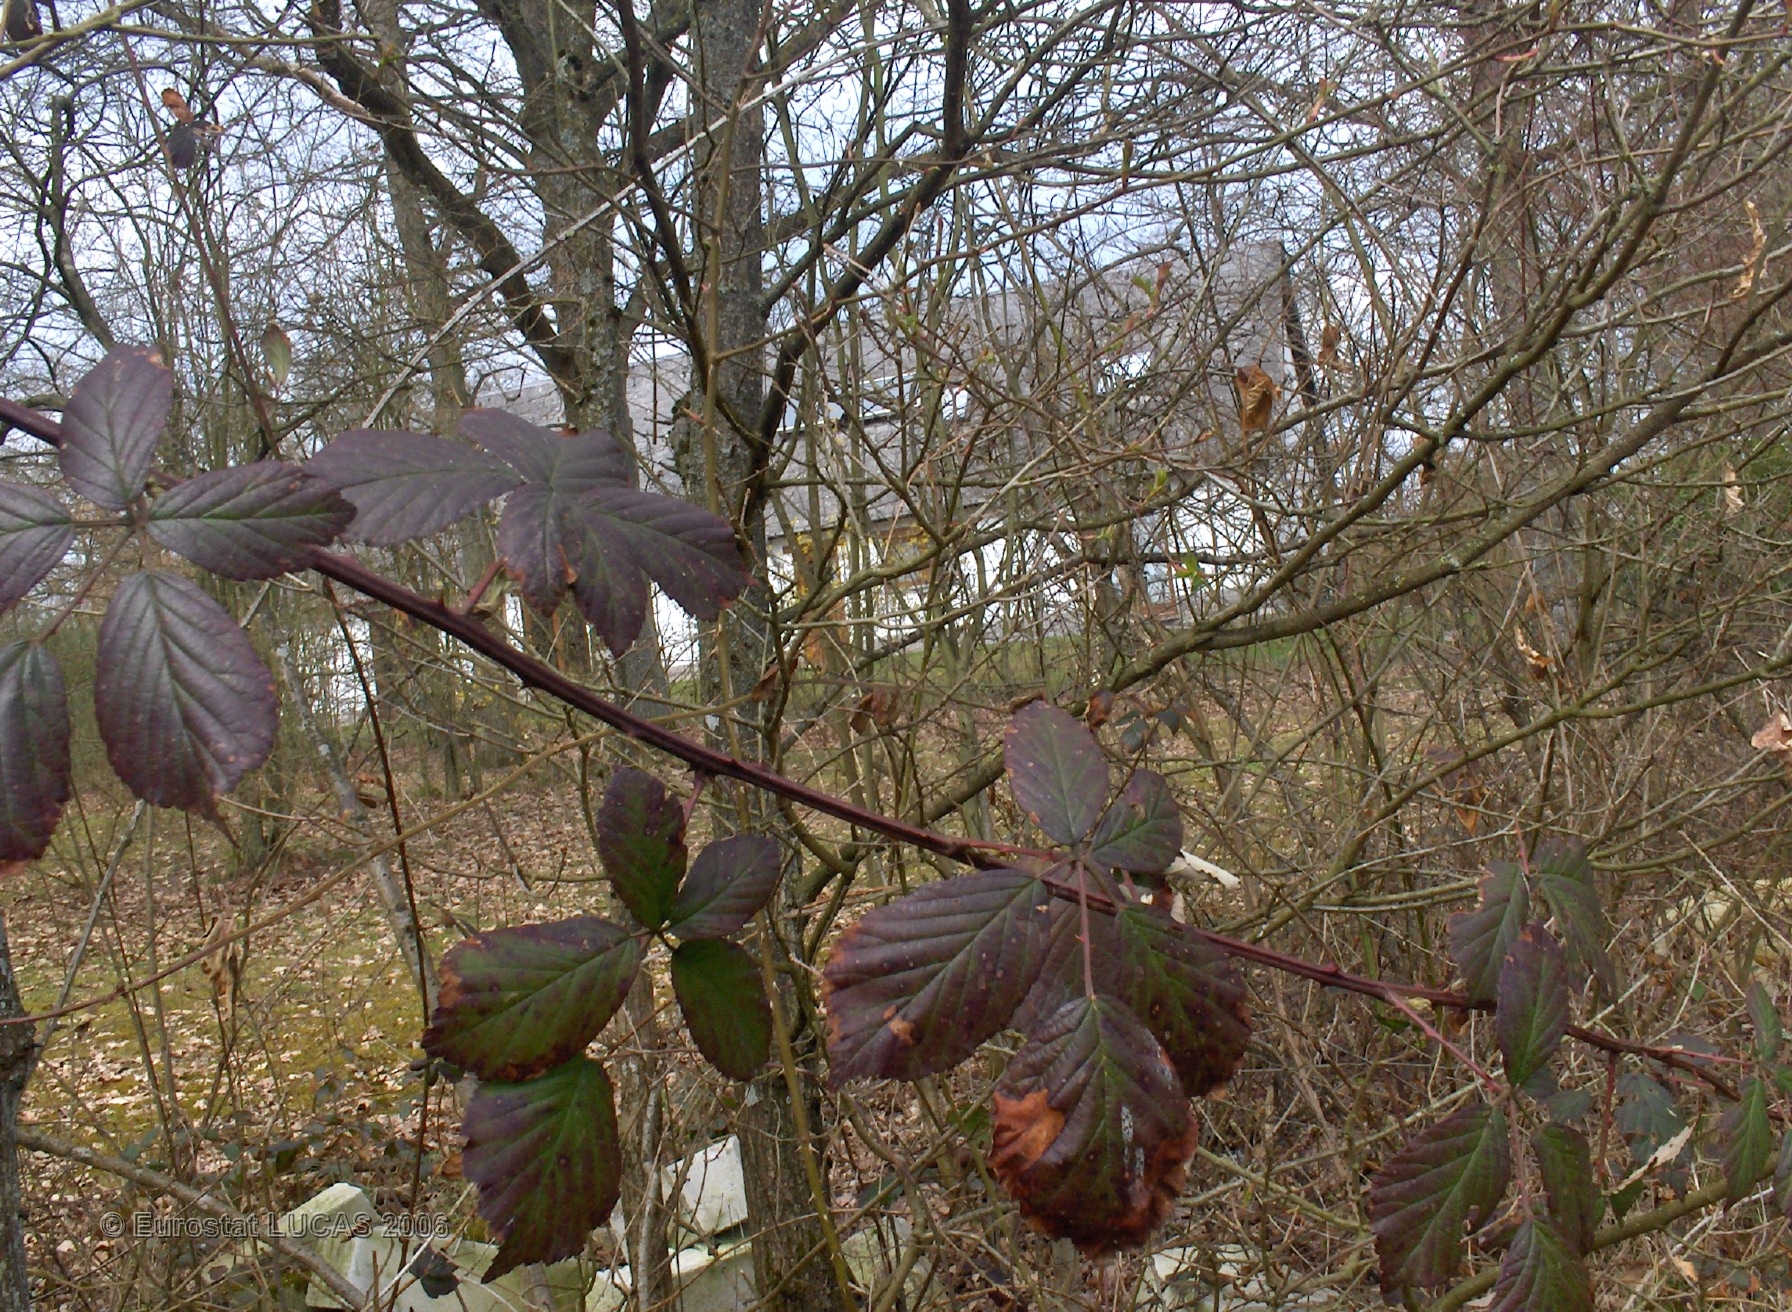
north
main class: Woodland
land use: Residential
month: April
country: BE
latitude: 50.1070
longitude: 4.5290
